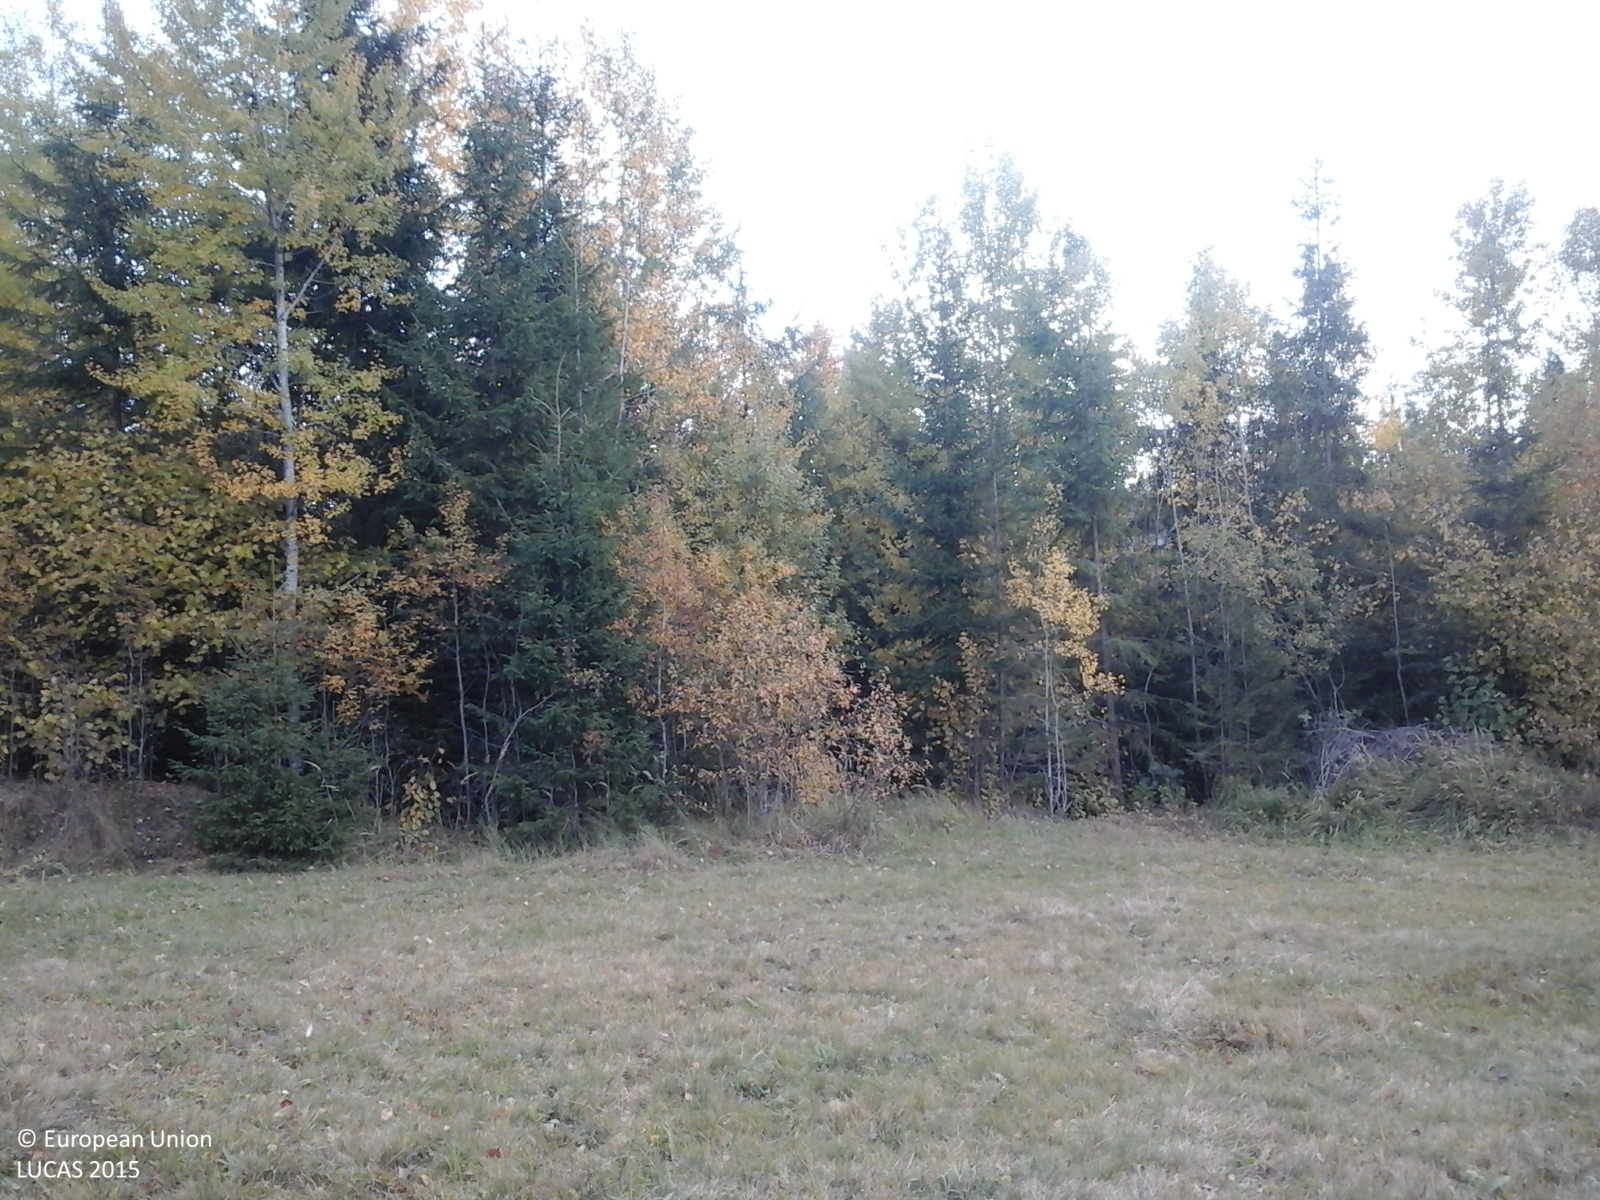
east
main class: Grassland
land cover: Grassland without tree/shrub cover
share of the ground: > 75 %
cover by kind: herbaceous plants 100 %
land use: Agriculture (excluding fallow land and kitchen gardens)
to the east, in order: Grassland without tree/shrub cover; Spruce dominated mixed woodland; Grassland without tree/shrub cover; Artificial constructions in urban areas; Grassland without tree/shrub cover
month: October
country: RO
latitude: 46.5488
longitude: 25.5120
